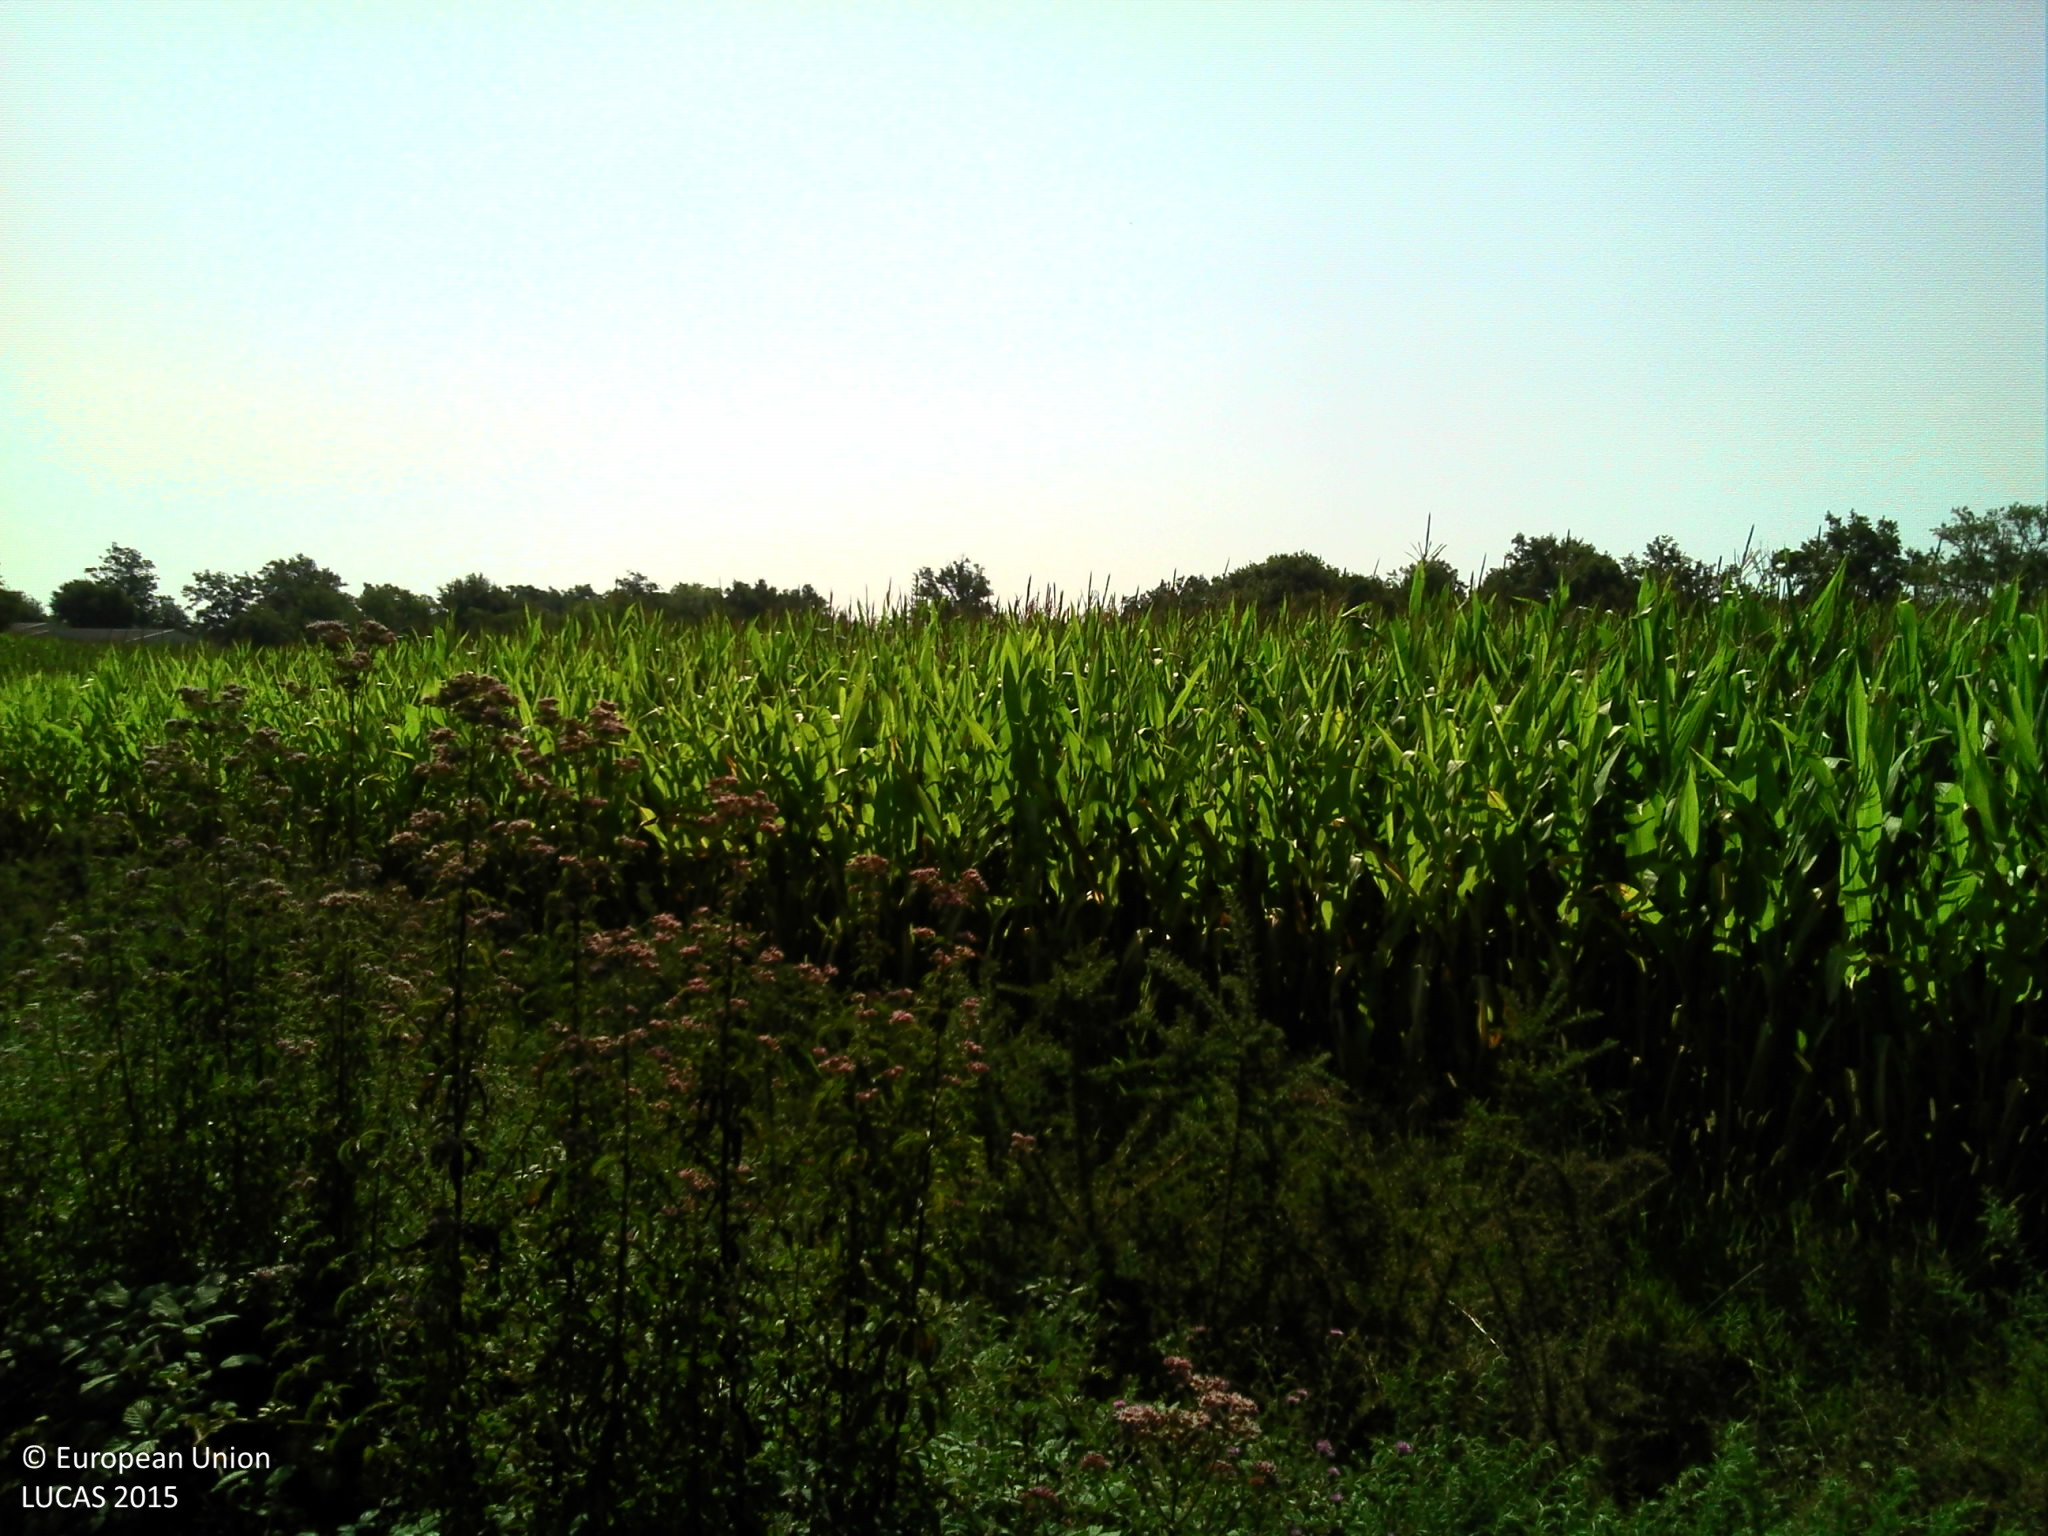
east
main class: Cropland
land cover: Maize
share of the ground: > 75 %
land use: Agriculture (excluding fallow land and kitchen gardens)
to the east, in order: Maize; Shruby margins; Ditches and canals; Shruby margins; Maize; Grassland without tree/shrub cover; Artificial constructions in urban areas
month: August
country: FR
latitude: 43.7918
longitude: -0.5627
